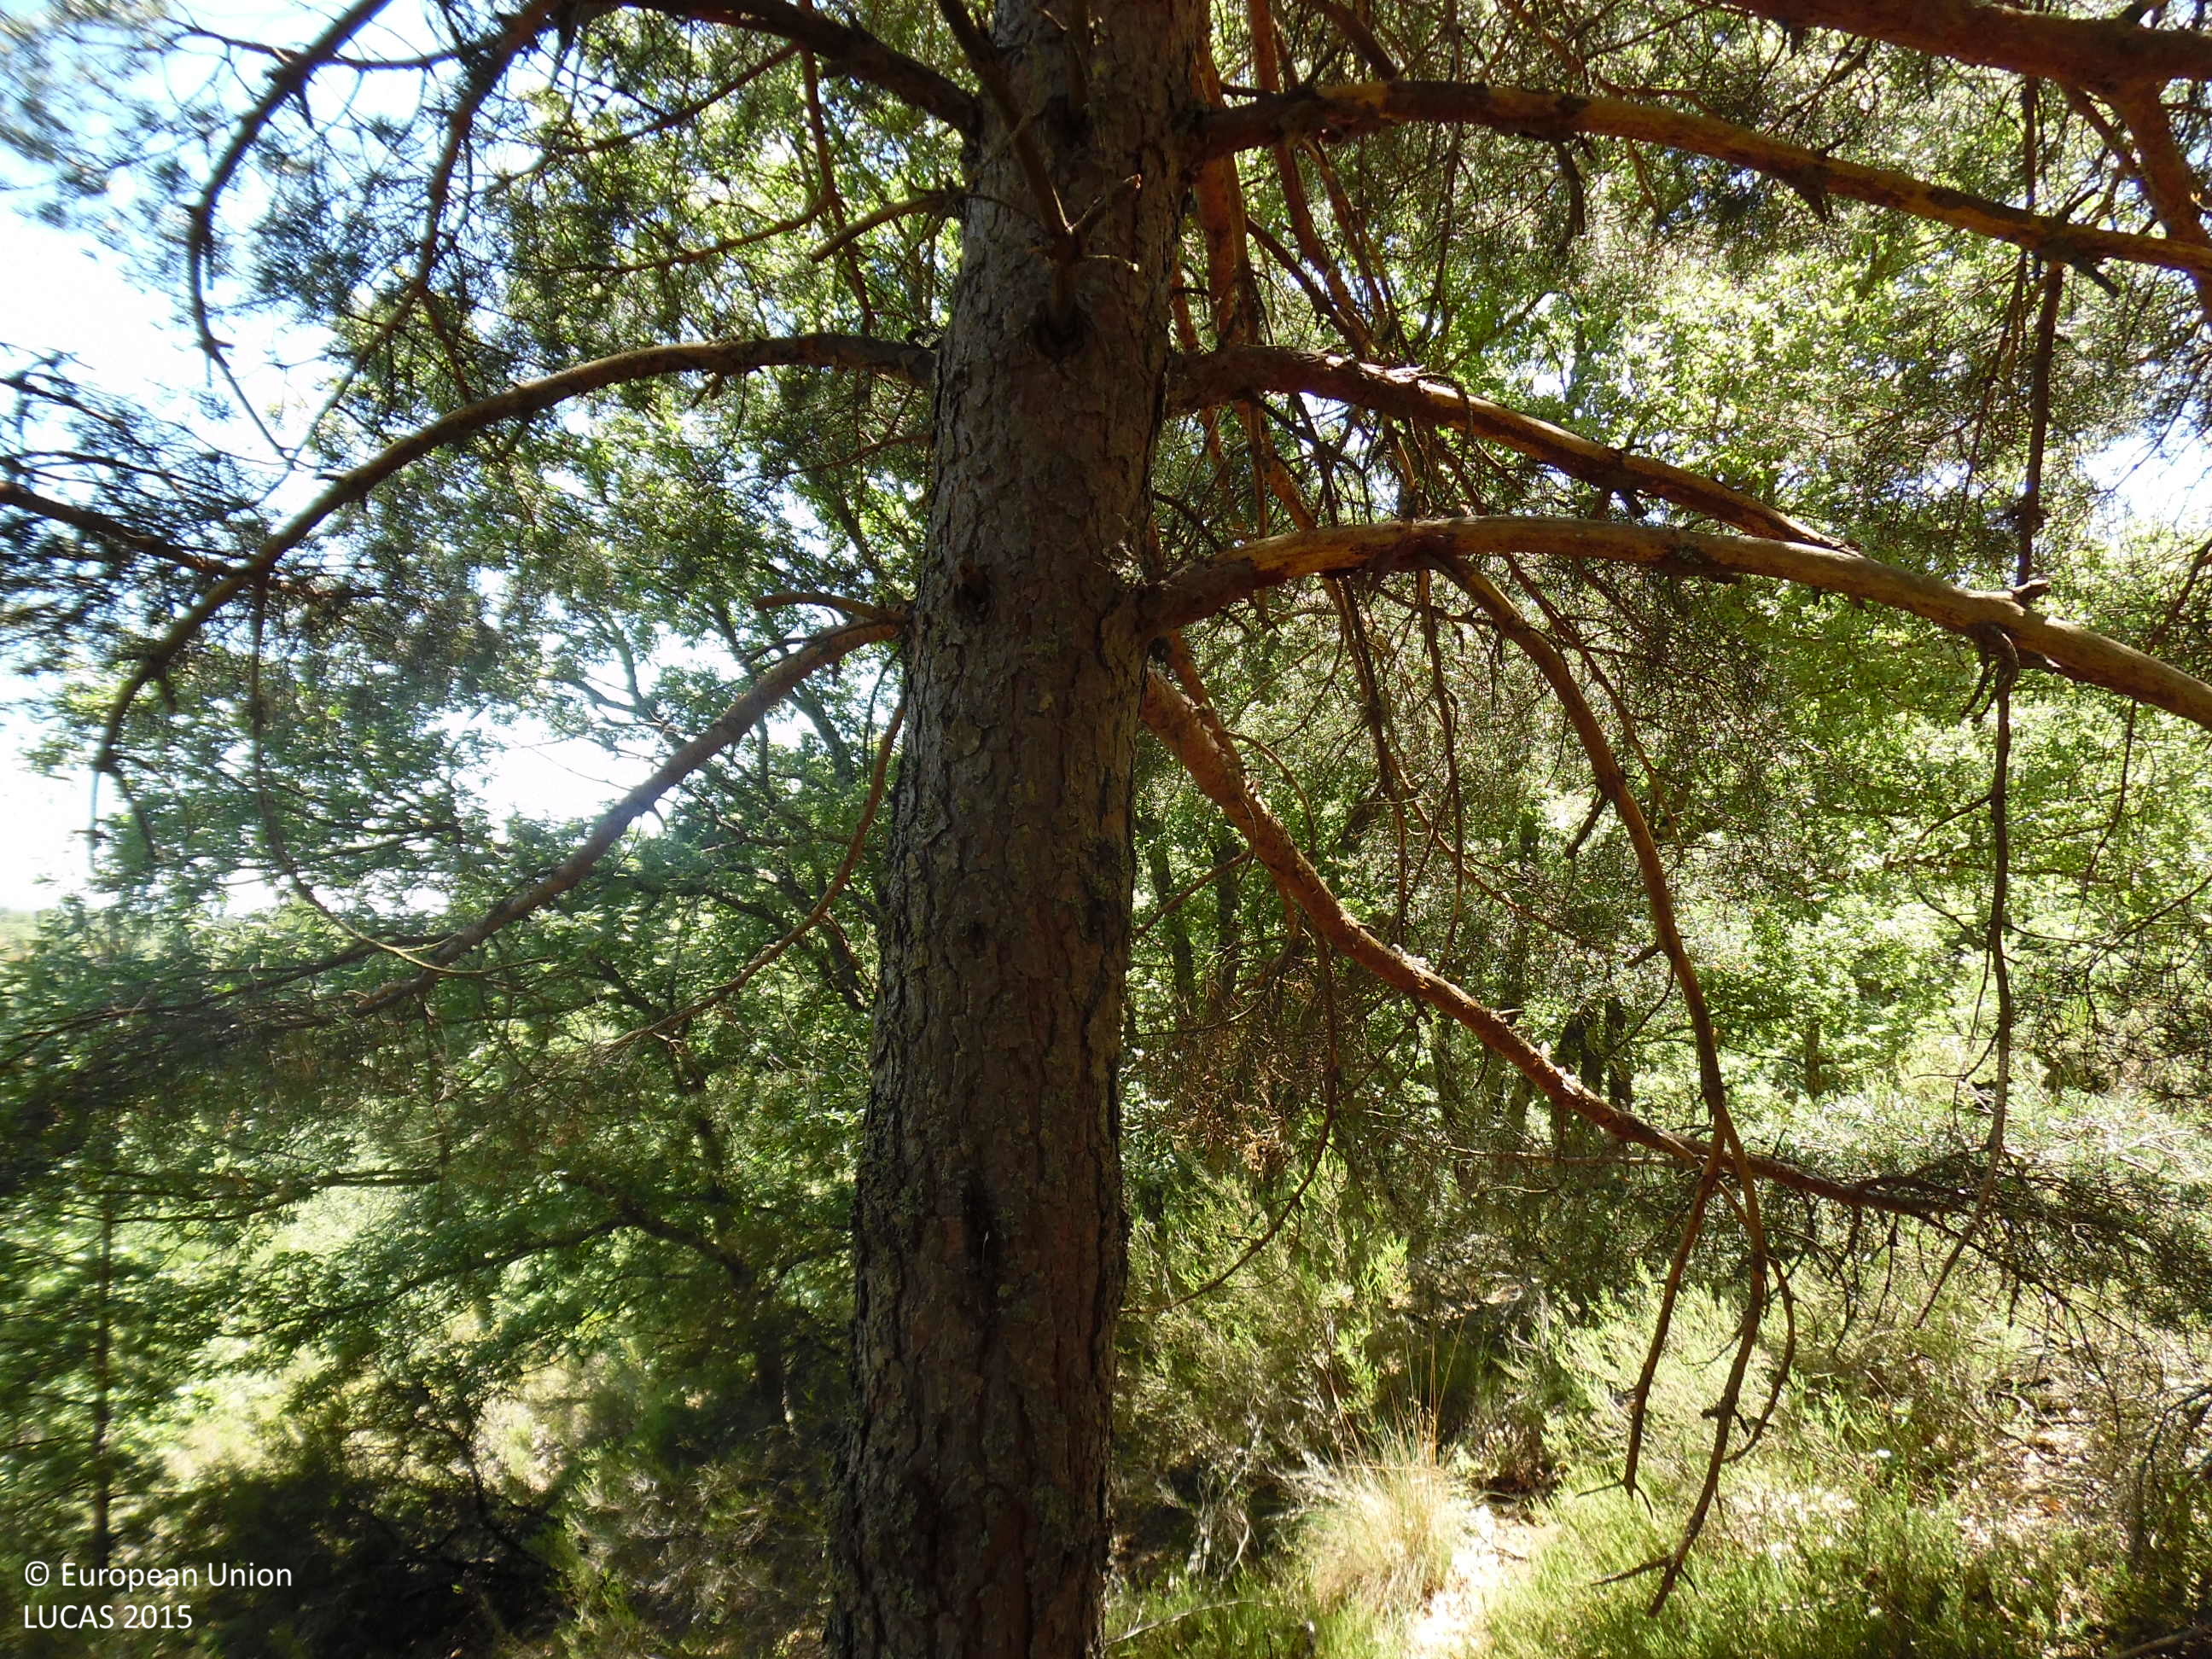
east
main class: Woodland
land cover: Pine dominated coniferous woodland
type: coniferous forest of the mediterranean region
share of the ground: 50 - 75 %
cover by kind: coniferous forest trees 95 %, shrubs 5 %
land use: Forestry
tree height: > 5 m
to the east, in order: Pine dominated coniferous woodland; Broadleaved woodland; Pine dominated coniferous woodland; Shrubland with sparse tree cover; Tracks; Shrubland without tree cover; Broadleaved woodland
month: June
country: ES
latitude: 42.5433
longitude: -6.1460
